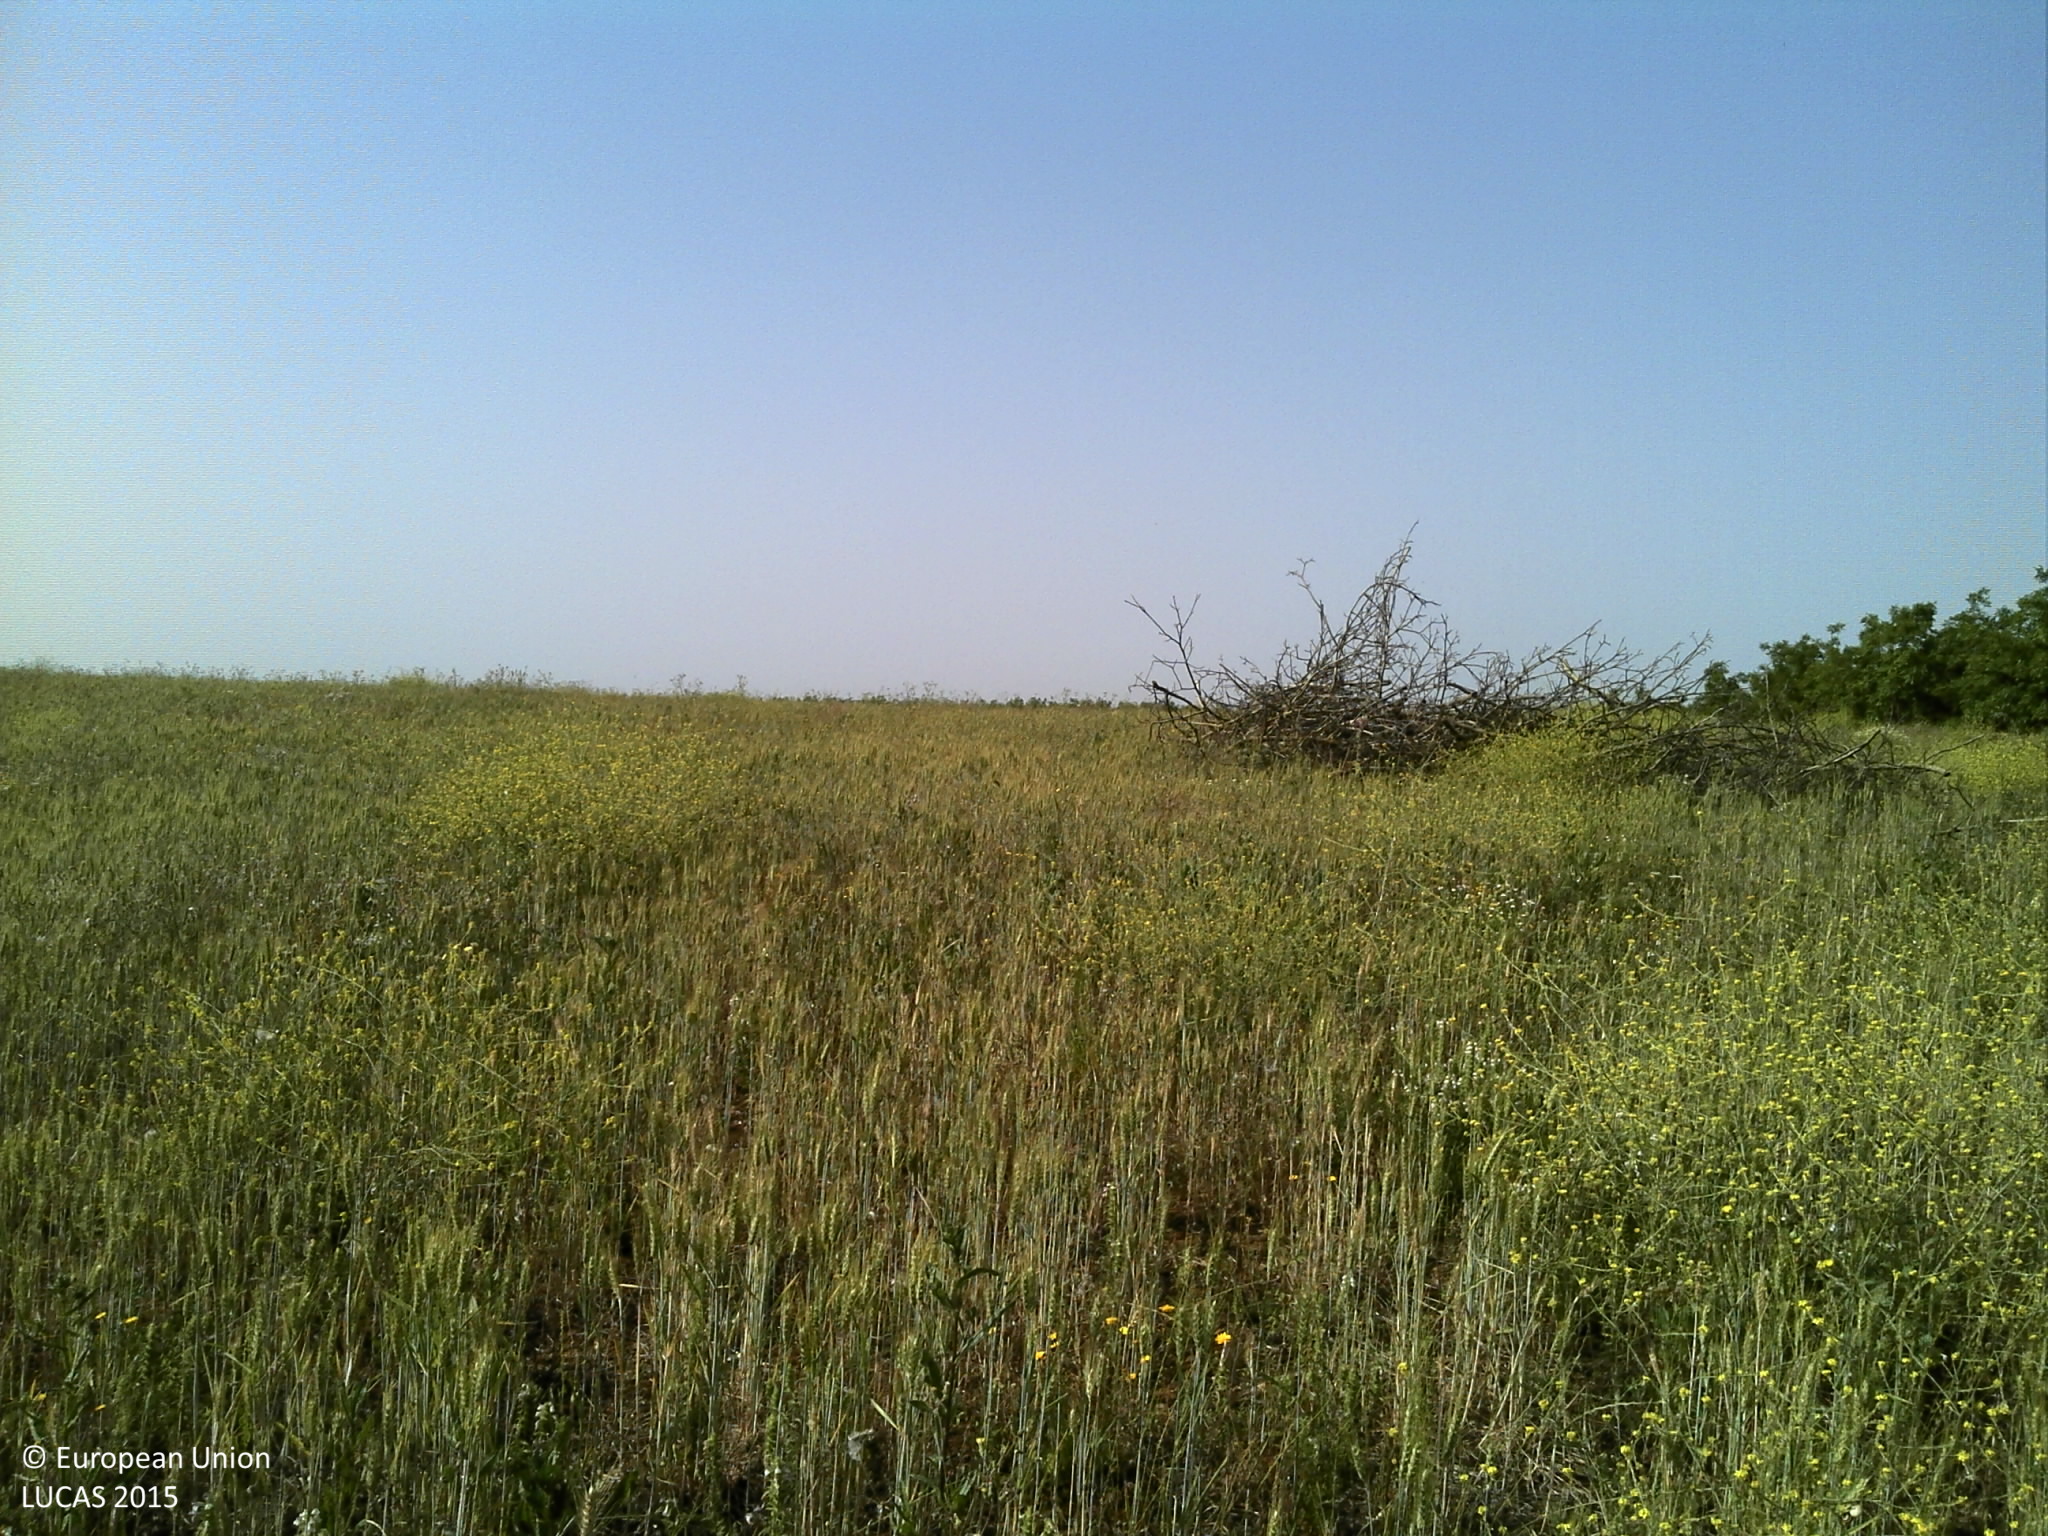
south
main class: Cropland
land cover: Mixed cereals for fodder
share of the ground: > 75 %
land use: Agriculture (excluding fallow land and kitchen gardens)
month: May
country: PT
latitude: 38.9784
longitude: -7.7861
